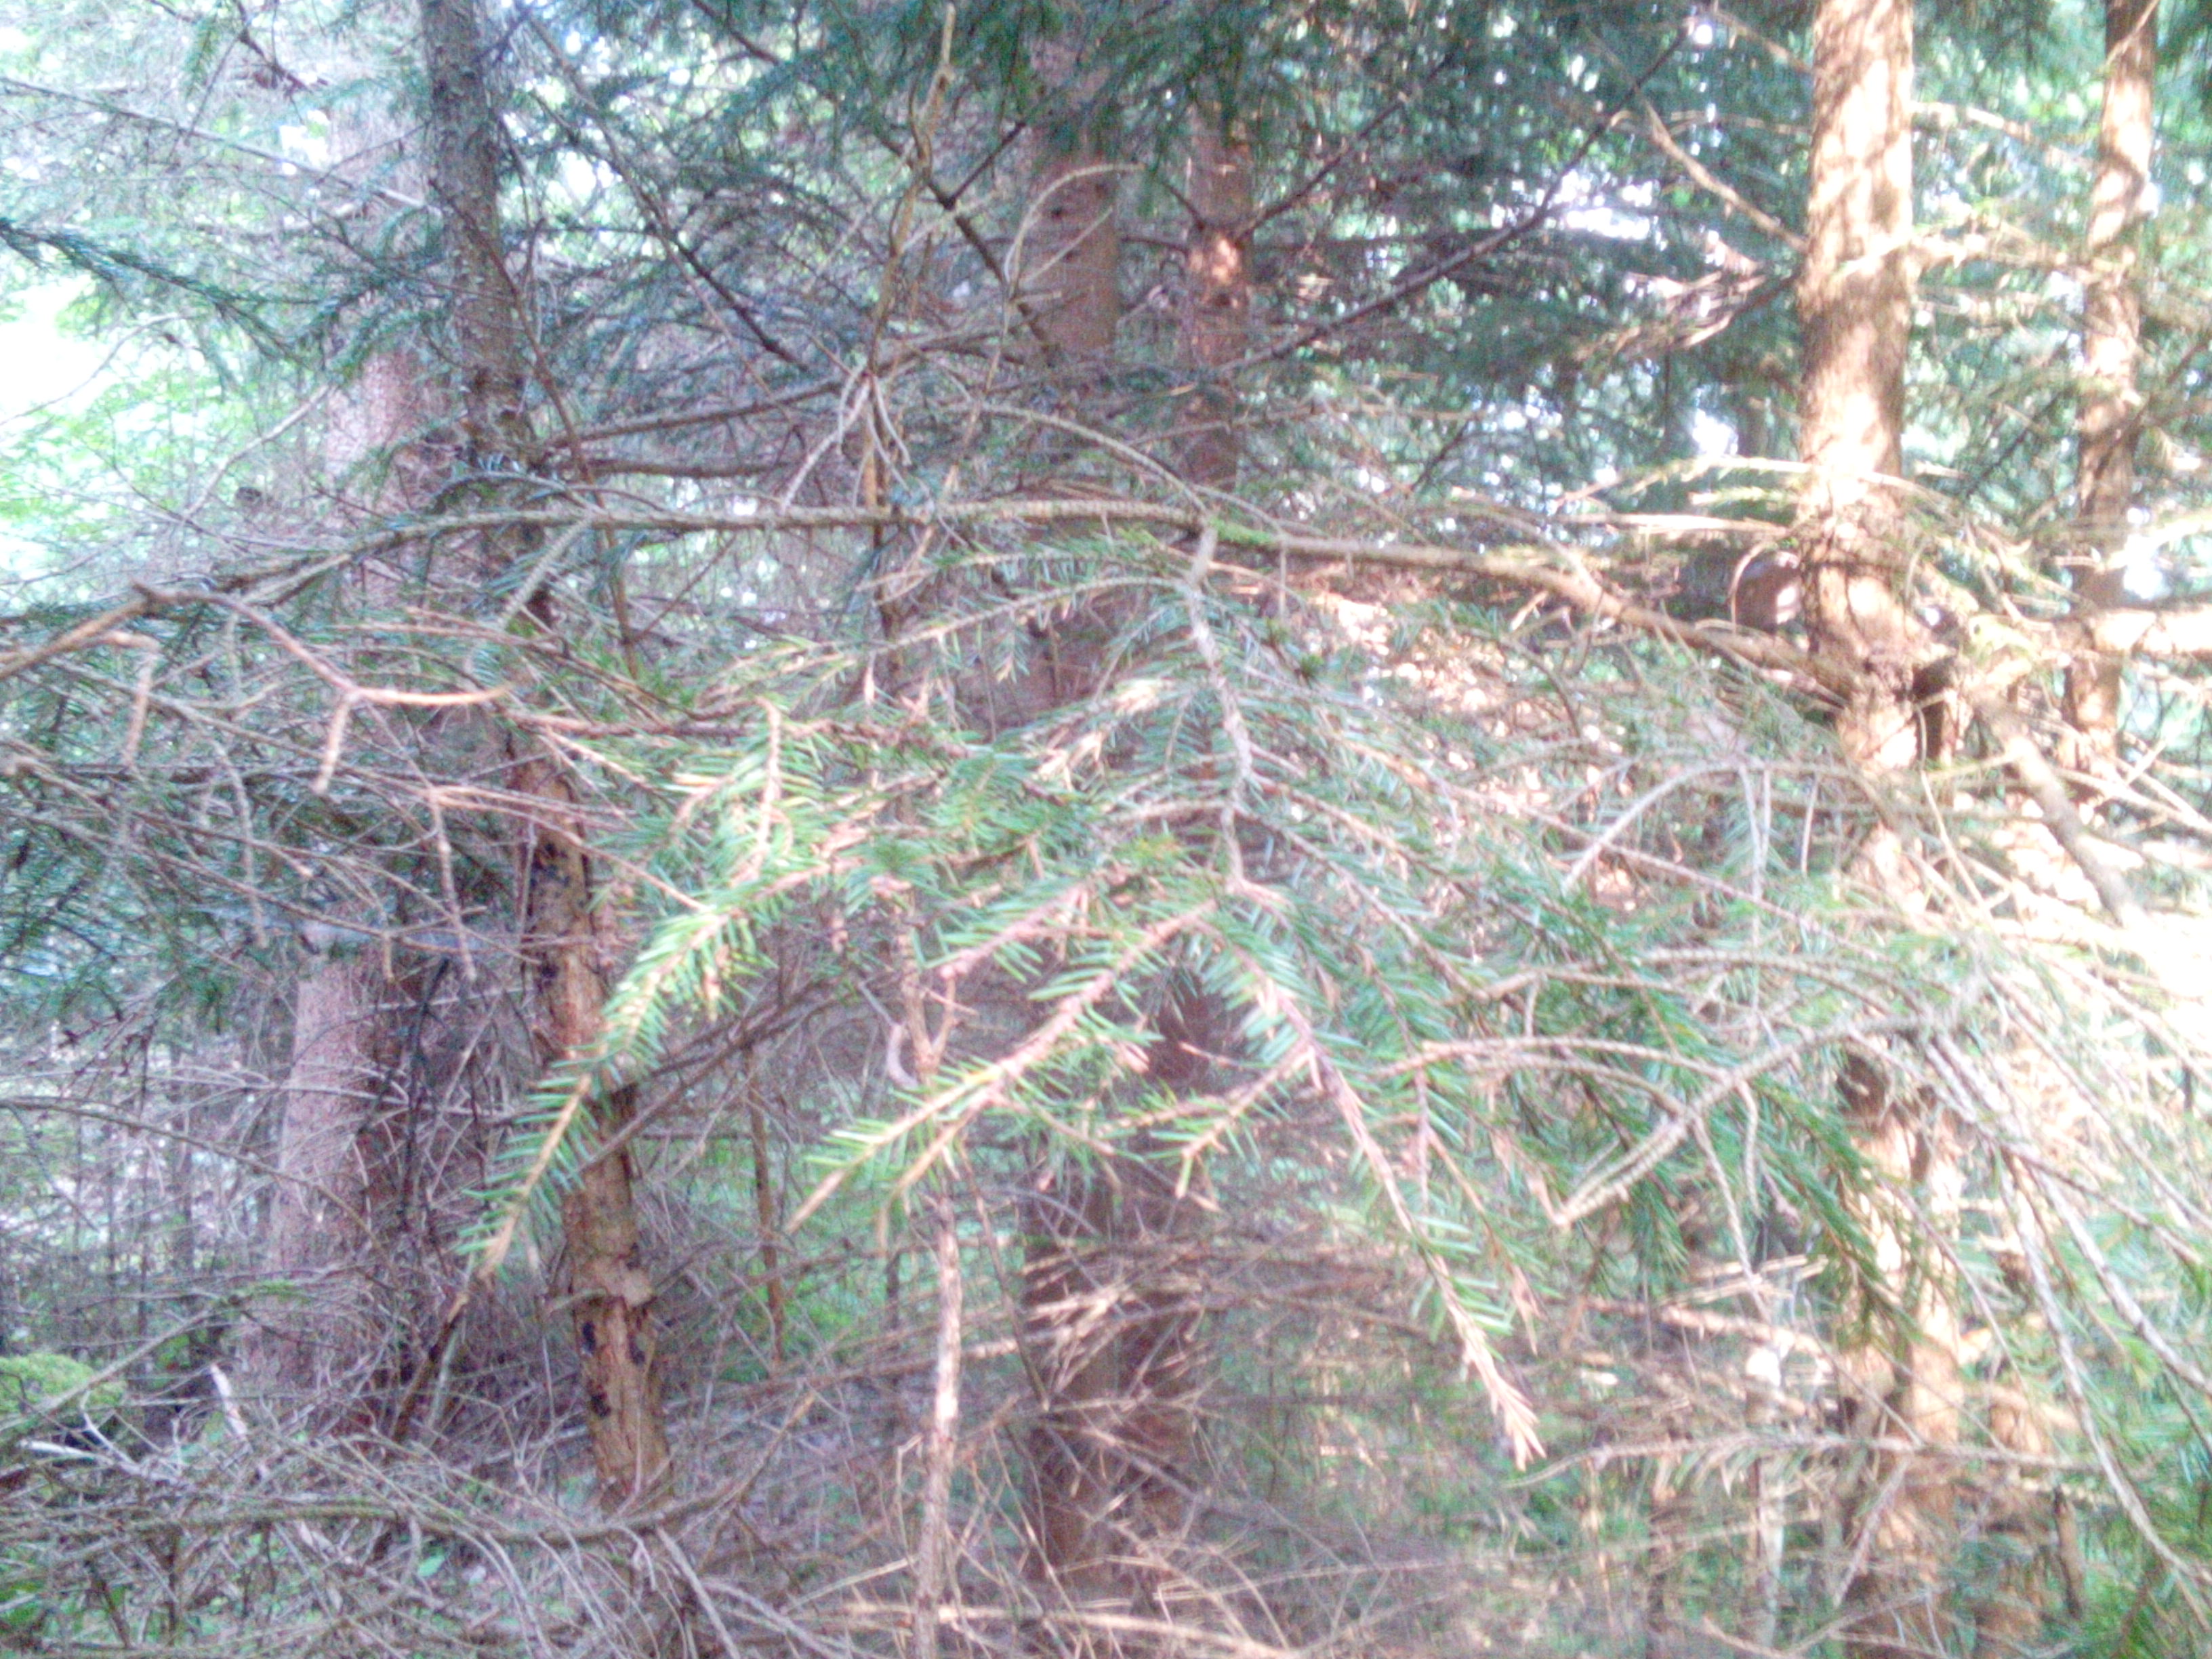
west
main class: Woodland
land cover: Spruce dominated mixed woodland
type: hemiboreal forest and nemoral coniferous forest and mixed broadleaved-coniferous forest
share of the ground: > 75 %
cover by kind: broadleaved forest trees 55 %, coniferous forest trees 30 %, herbaceous plants 10 %, shrubs 5 %
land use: Forestry
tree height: > 5 m
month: July
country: LV
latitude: 56.5885
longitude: 21.7861
